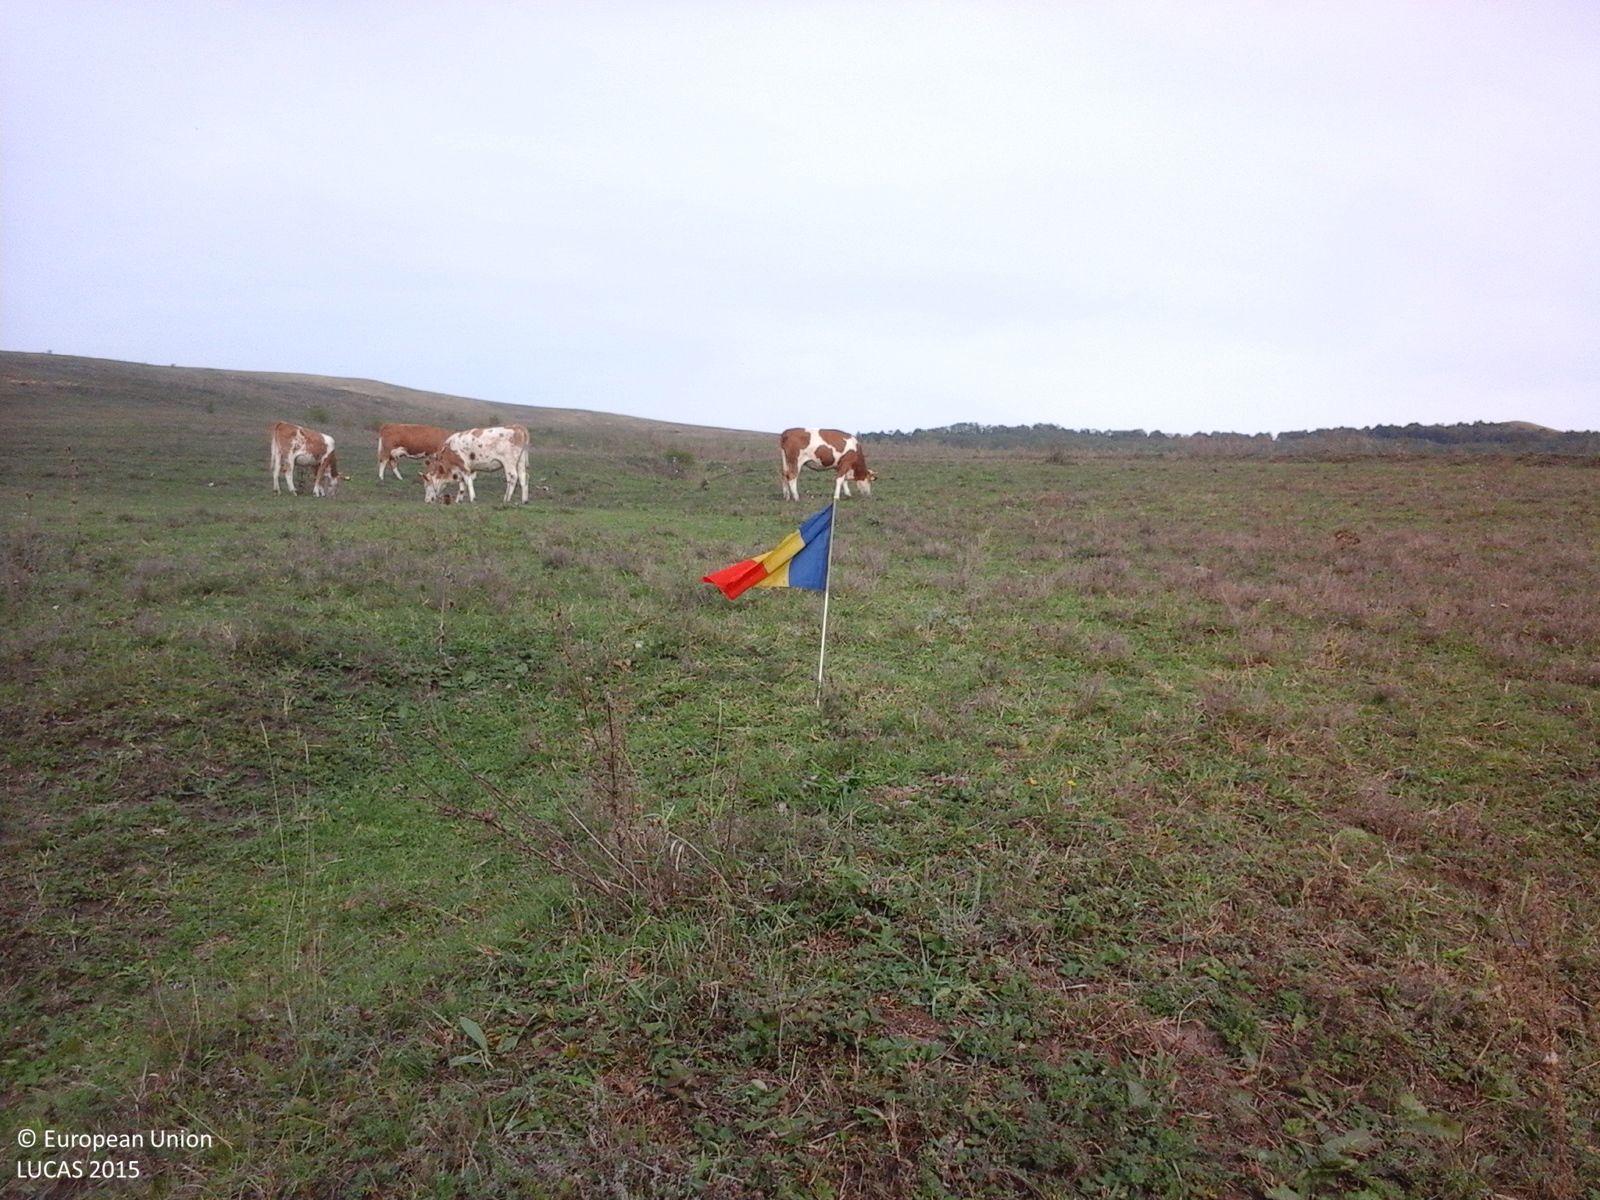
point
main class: Grassland
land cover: Grassland without tree/shrub cover
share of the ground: > 75 %
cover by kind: herbaceous plants 100 %
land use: Agriculture (excluding fallow land and kitchen gardens)
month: September
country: RO
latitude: 46.8126
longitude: 24.1439
